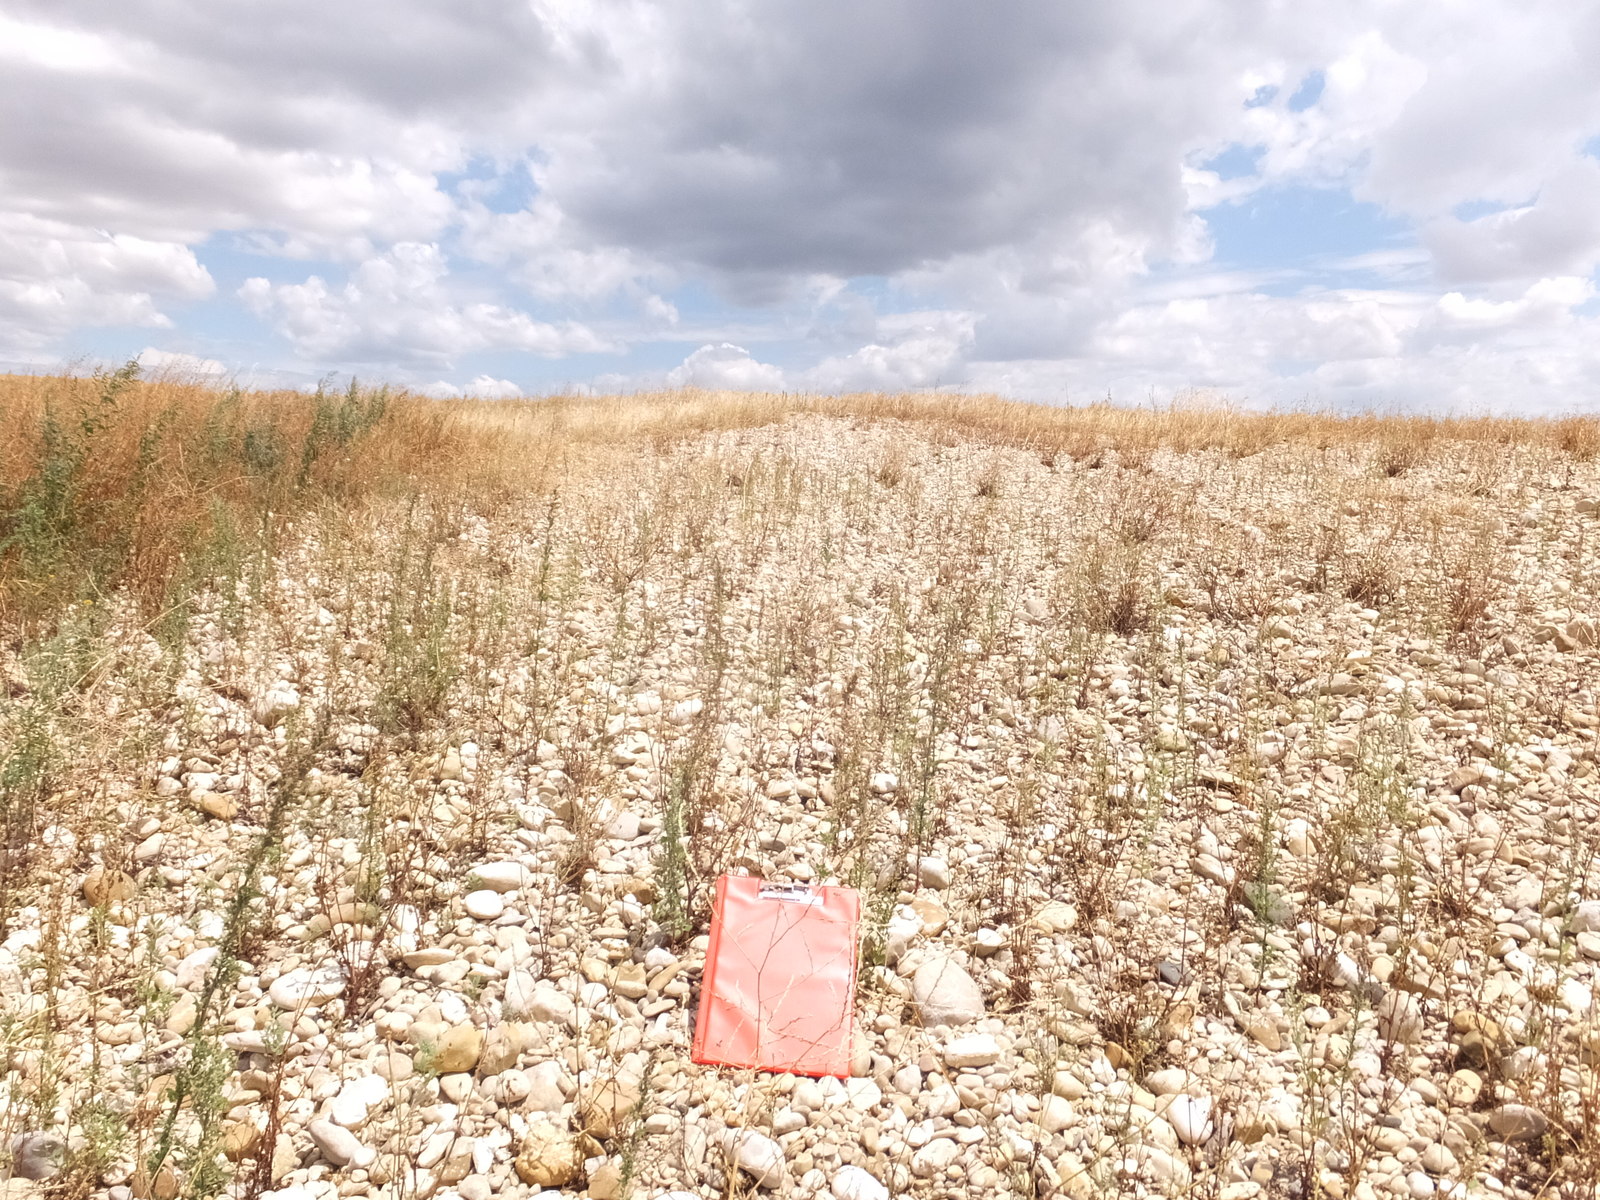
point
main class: Grassland
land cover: Spontaneously vegetated surfaces
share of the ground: 25 - 50 %
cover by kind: consolidated bare surface 80 %, herbaceous plants 20 %
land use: Fallow land
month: June
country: ES
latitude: 41.2614
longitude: -0.0508
